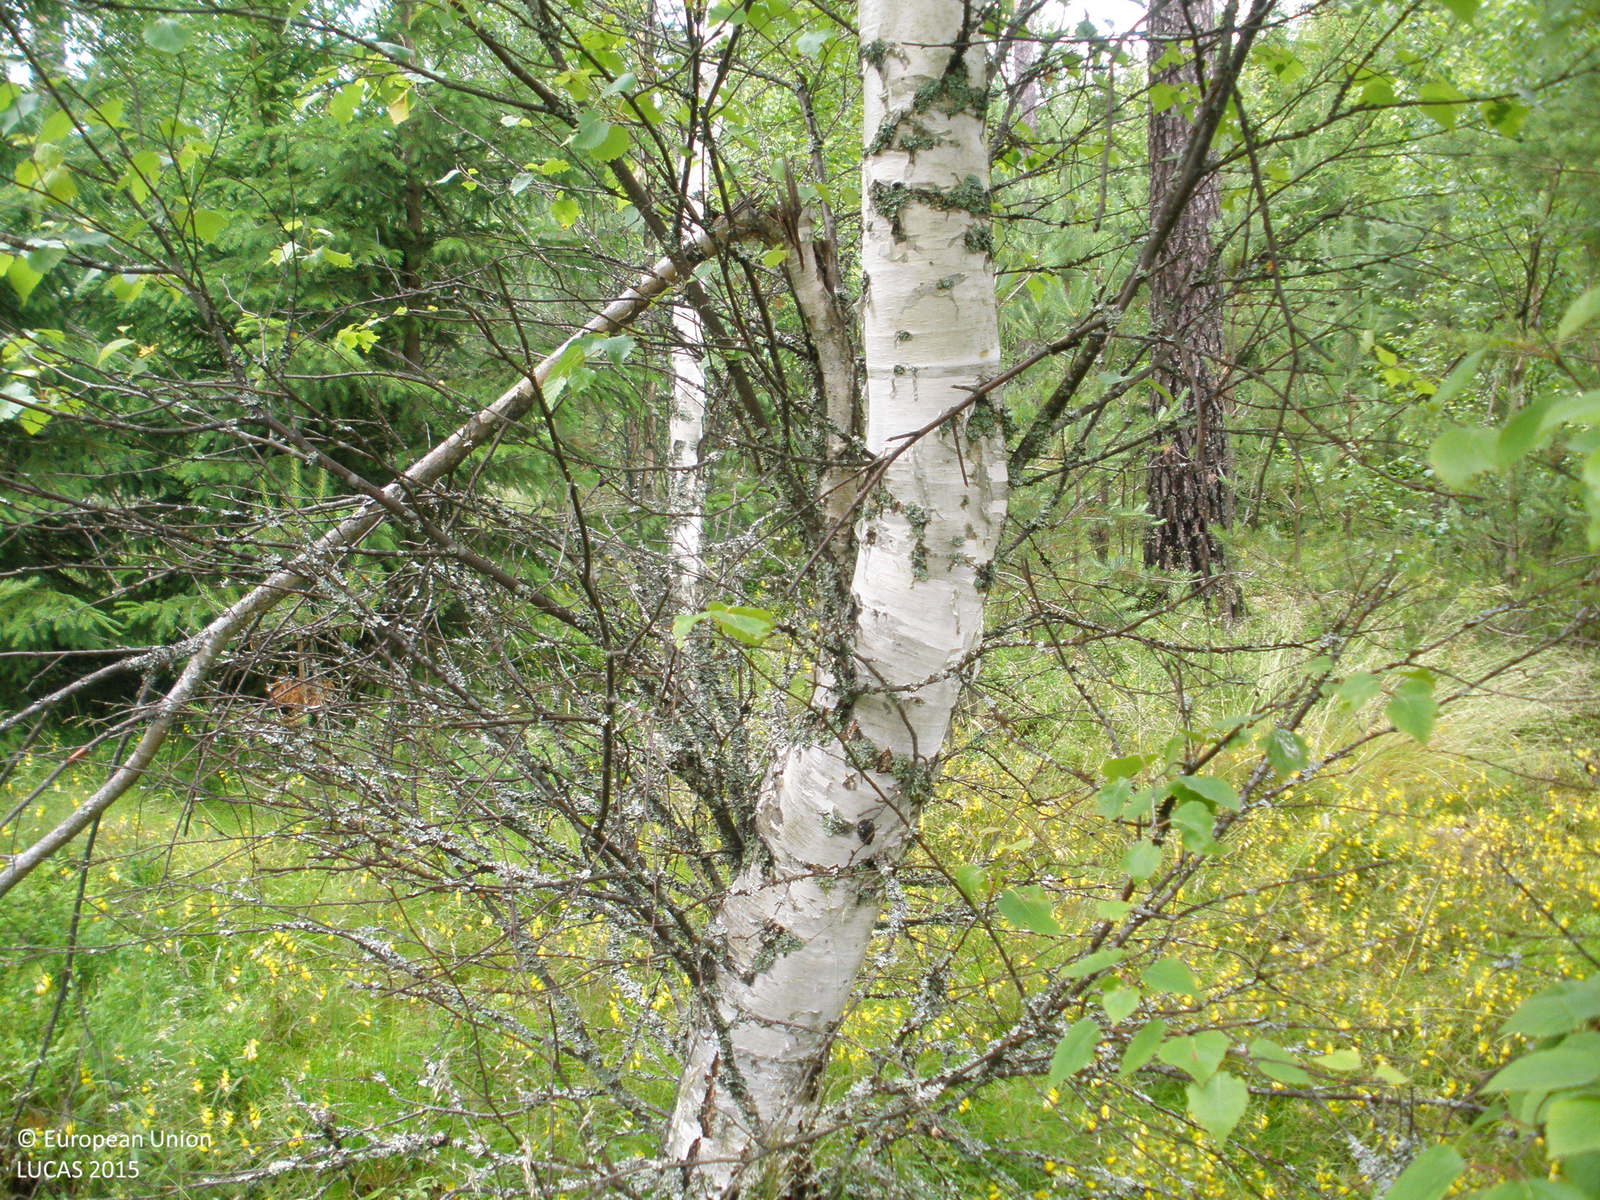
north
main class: Woodland
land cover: Other mixed woodland
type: boreal forest
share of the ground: 25 - 50 %
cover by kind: herbaceous plants 35 %, broadleaved forest trees 25 %, coniferous forest trees 20 %, shrubs 10 %, lichens and mosses 10 %
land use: Forestry
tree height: > 5 m
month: July
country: FI
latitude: 61.3603
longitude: 23.6808
